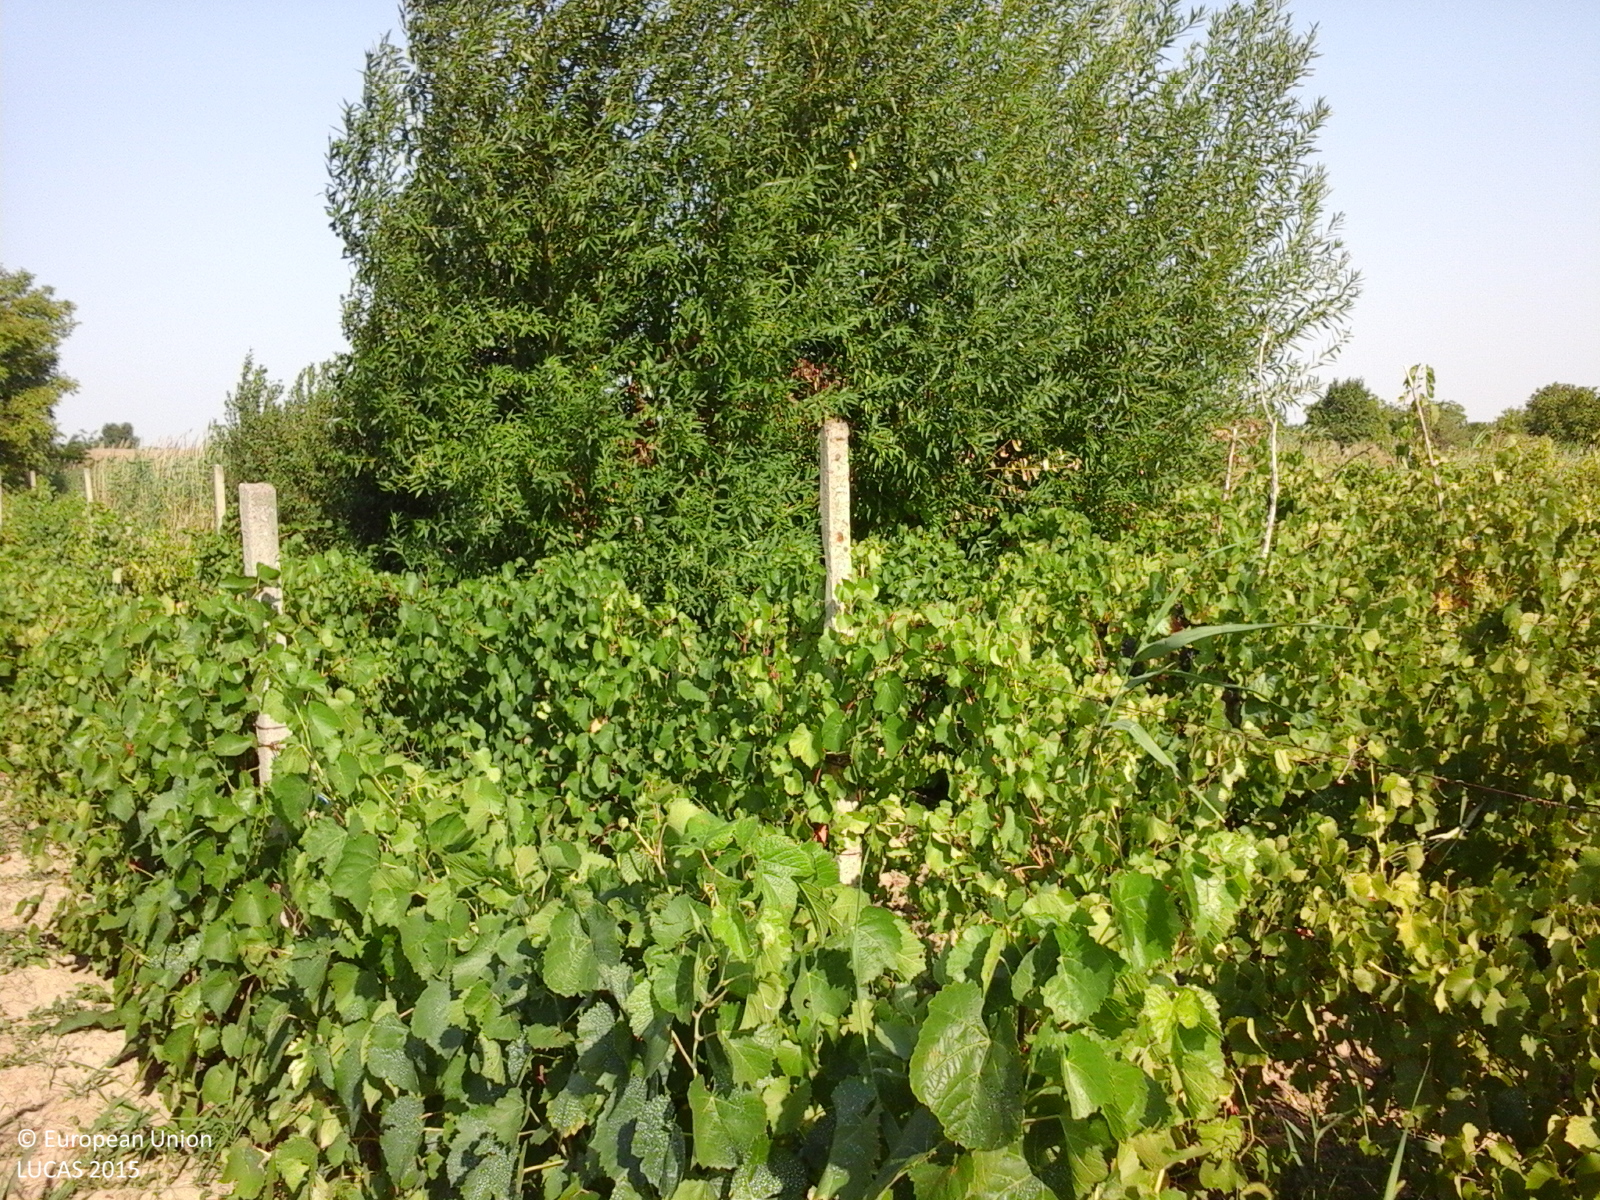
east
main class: Cropland
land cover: Vineyards
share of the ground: > 75 %
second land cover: Other bare soil
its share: > 75 %
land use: Agriculture (excluding fallow land and kitchen gardens)
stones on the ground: < 10 %
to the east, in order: Vineyards; Other bare soil; Vineyards; Single bushes/trees; Vineyards; Spontaneously vegetated surfaces; Tracks; Grassland without tree/shrub cover; Tracks; Grassland without tree/shrub cover; Tracks; Grassland without tree/shrub cover
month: August
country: RO
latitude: 45.5548
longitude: 27.5121
